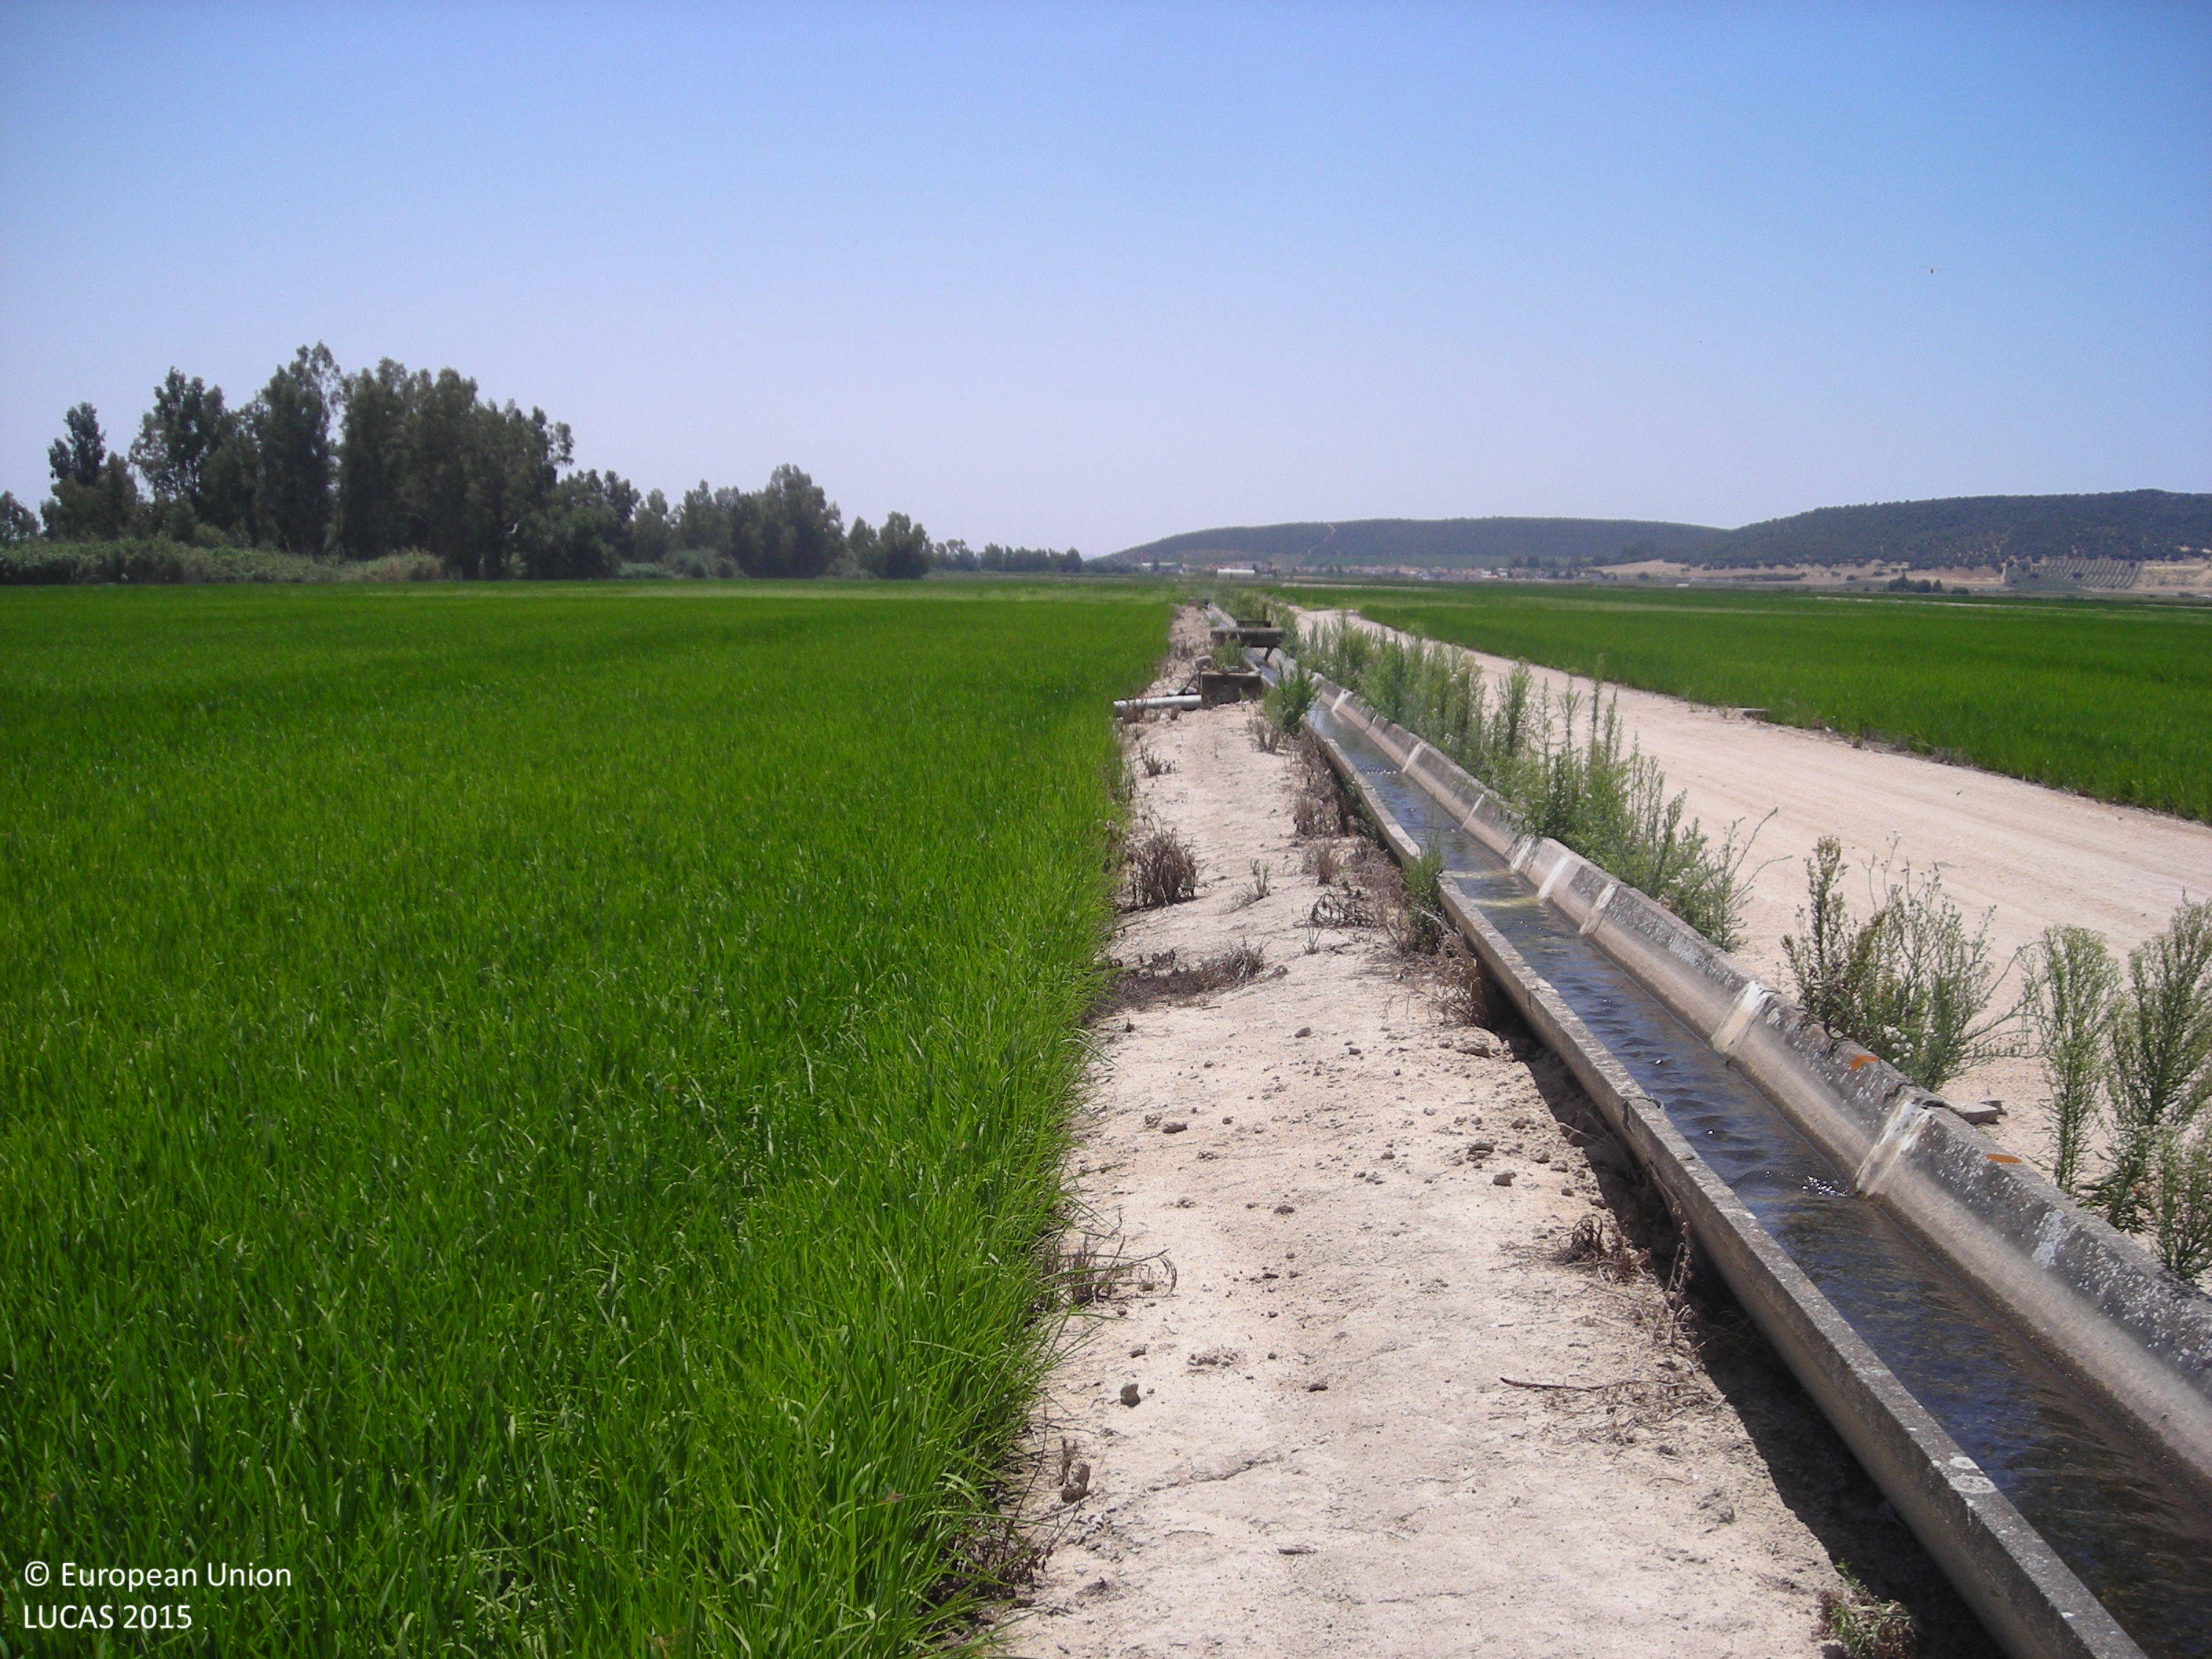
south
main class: Cropland
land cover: Rice
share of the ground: > 75 %
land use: Agriculture (excluding fallow land and kitchen gardens)
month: July
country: ES
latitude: 39.1047
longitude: -5.8124
